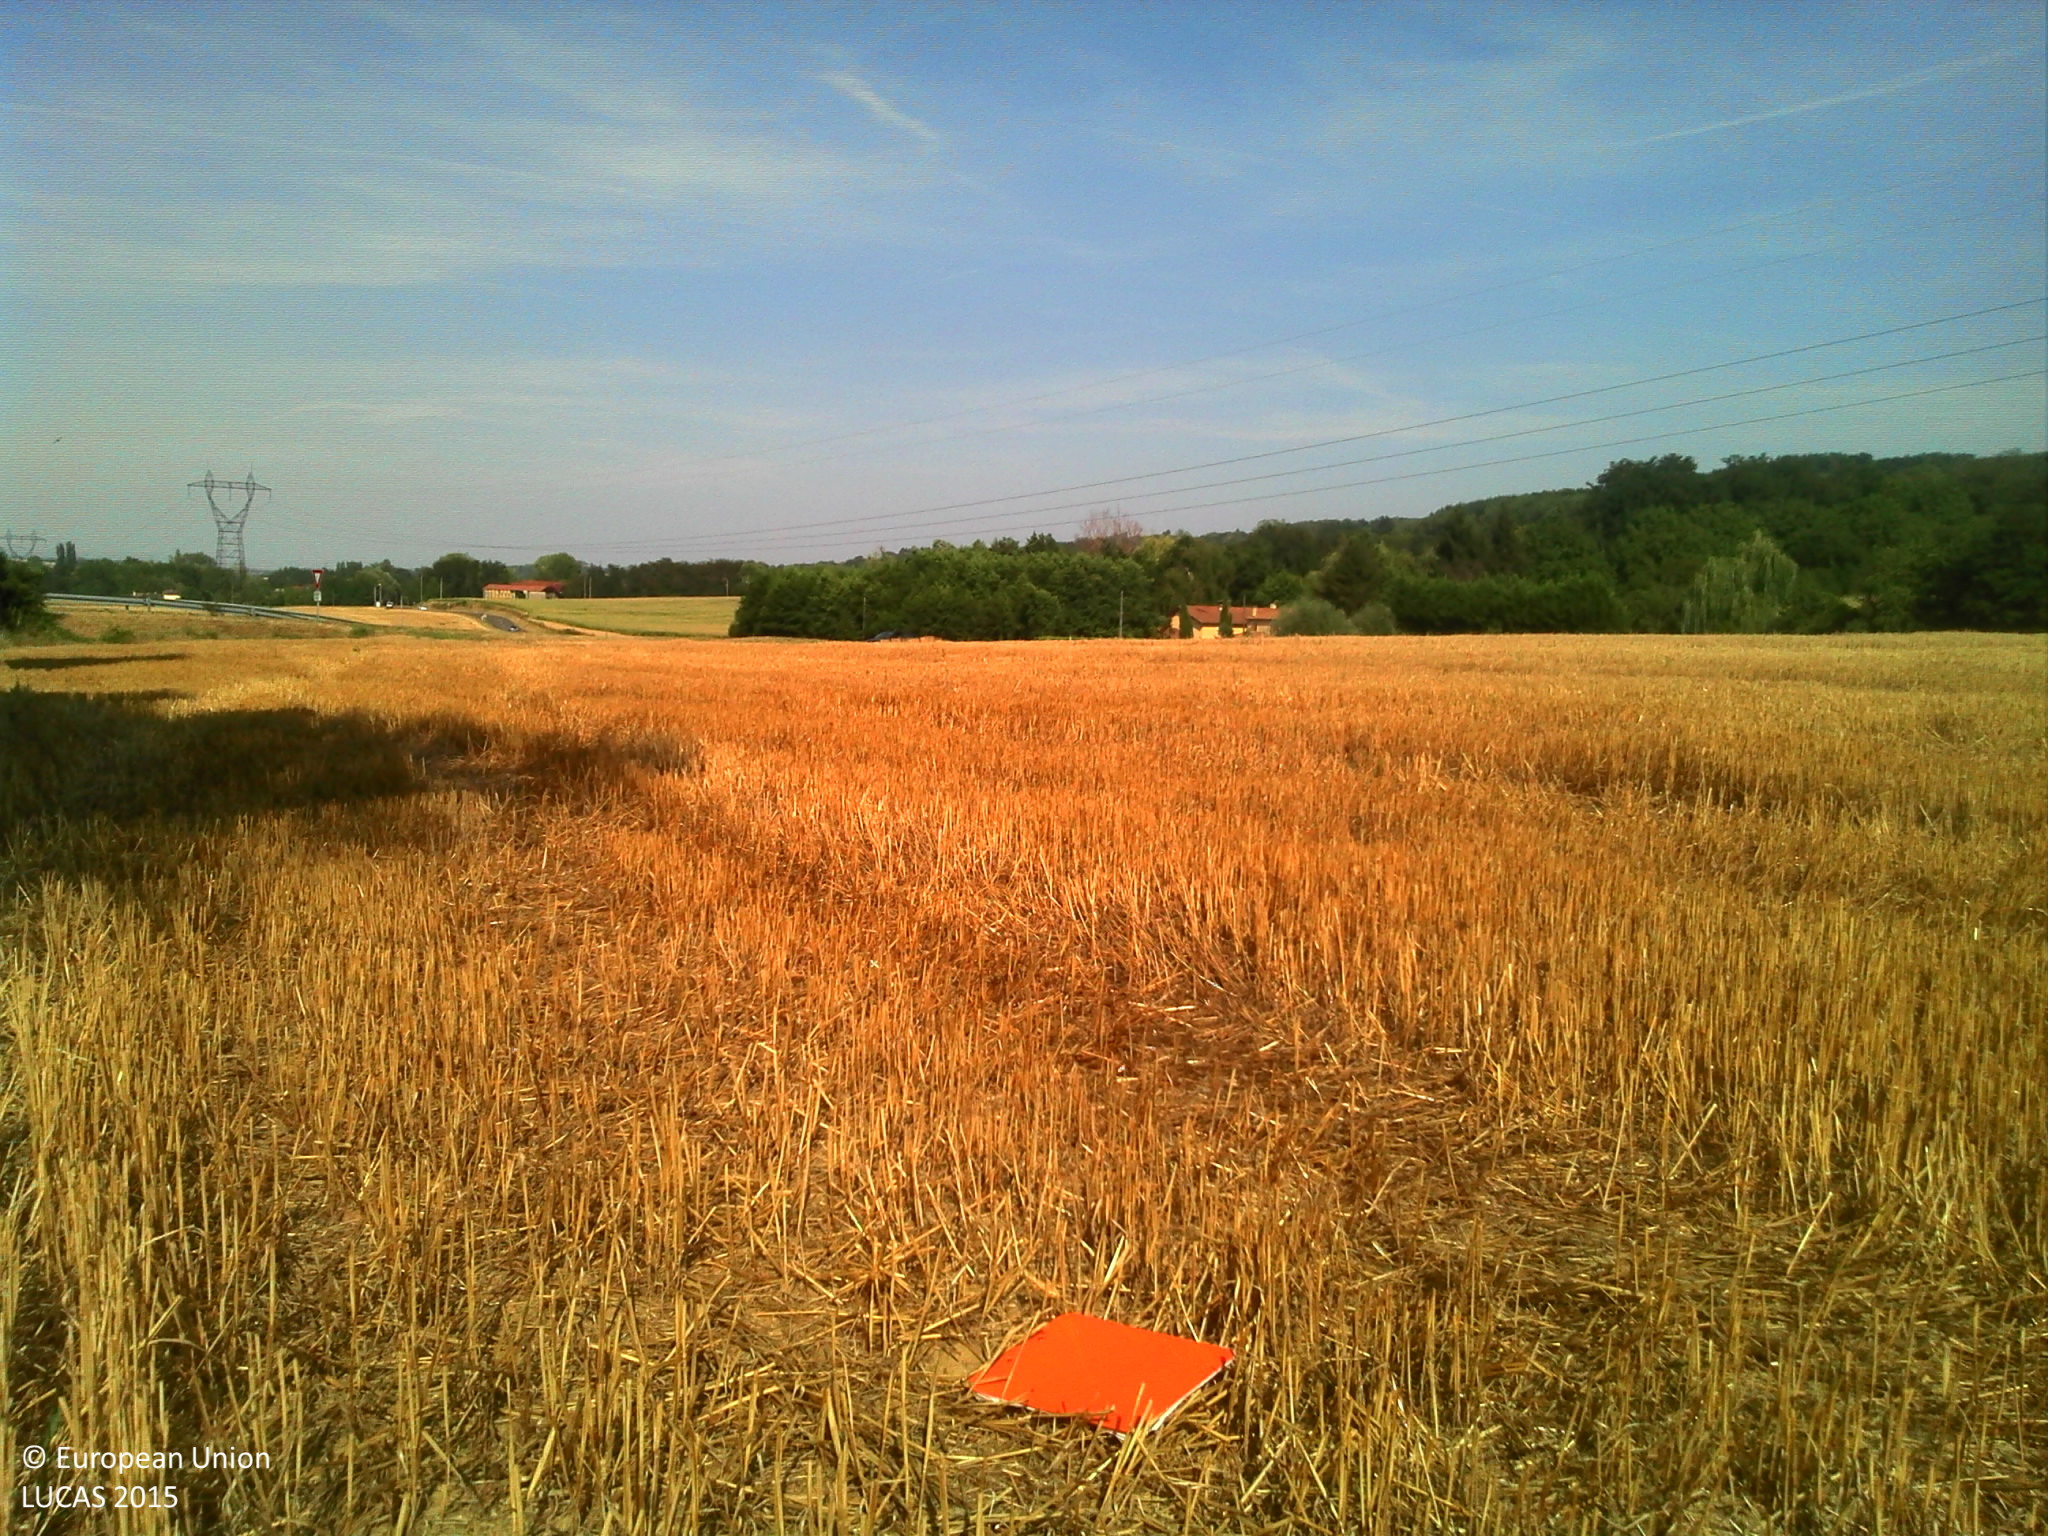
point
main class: Cropland
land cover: Durum wheat
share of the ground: 10 - 25 %
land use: Agriculture (excluding fallow land and kitchen gardens)
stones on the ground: 25 - 50 %
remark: Harvested field
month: August
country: FR
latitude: 45.6153
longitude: 4.8873
